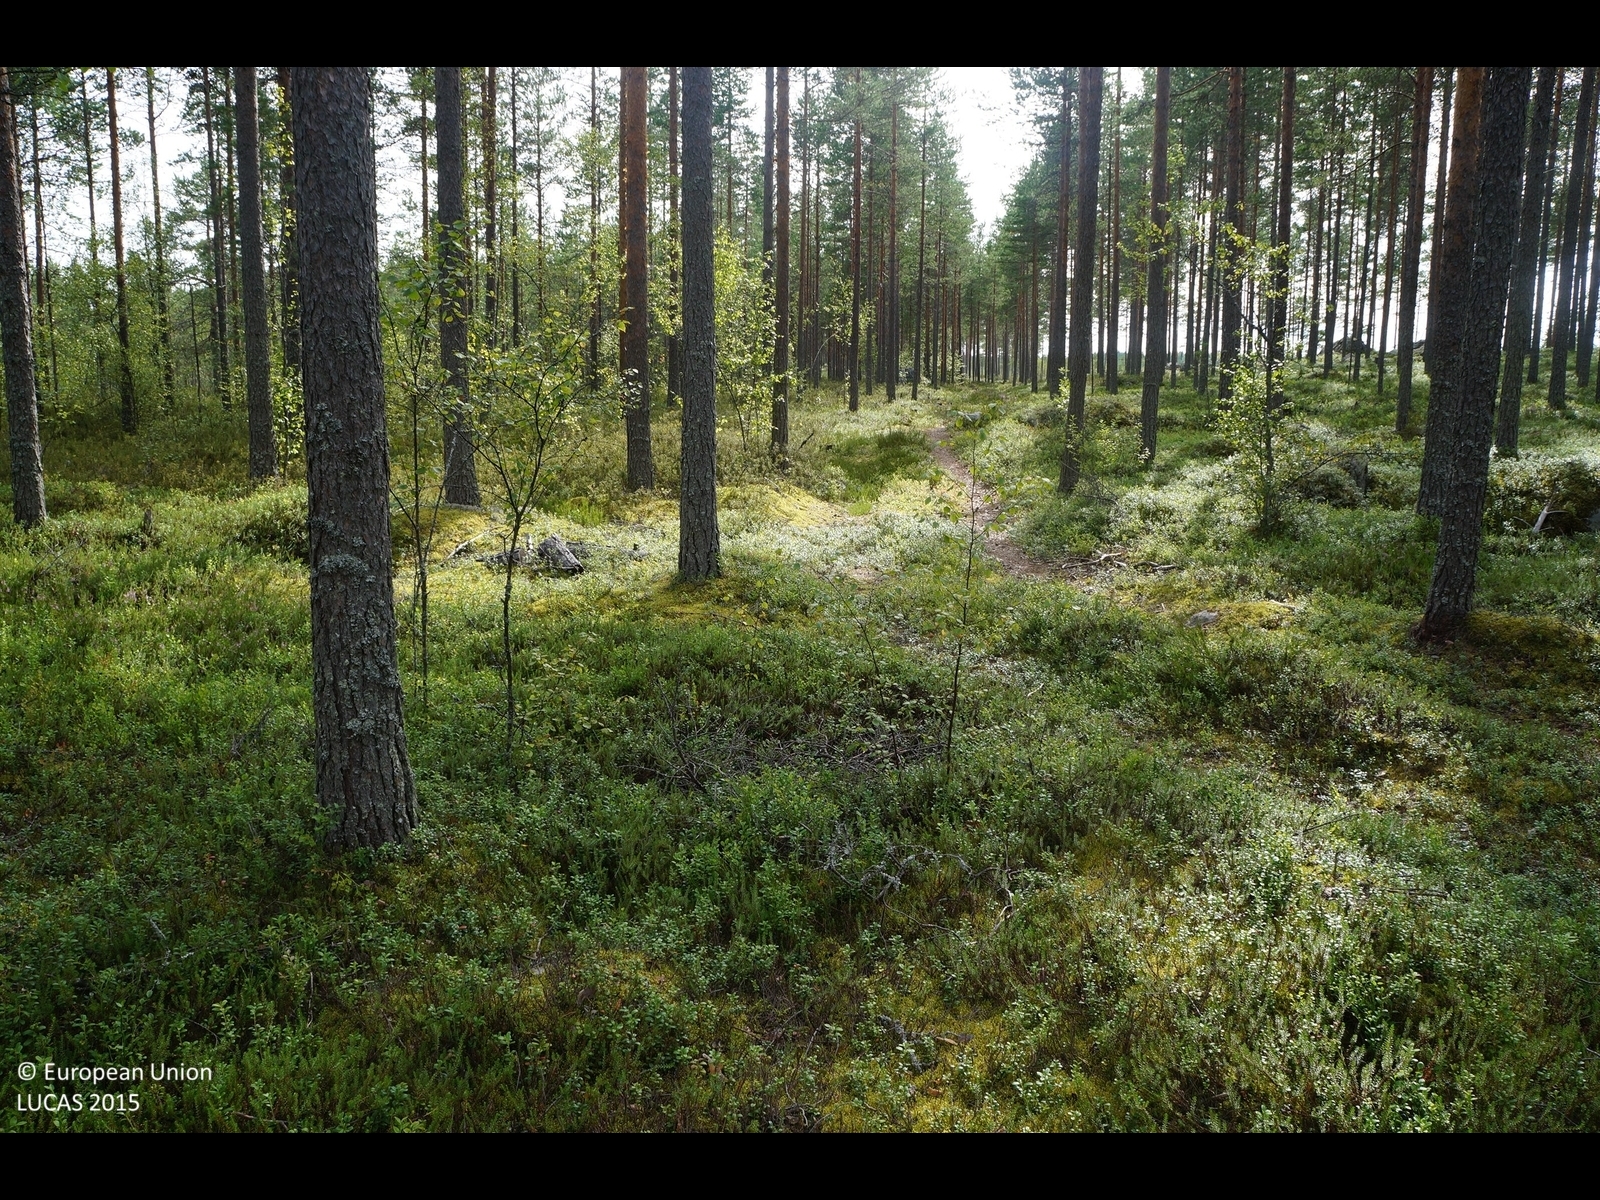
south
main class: Woodland
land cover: Pine dominated coniferous woodland
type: boreal forest
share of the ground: 50 - 75 %
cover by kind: coniferous forest trees 50 %, shrubs 45 %, lichens and mosses 5 %
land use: Forestry
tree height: > 5 m
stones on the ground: < 10 %
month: August
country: FI
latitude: 64.6199
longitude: 24.8155
